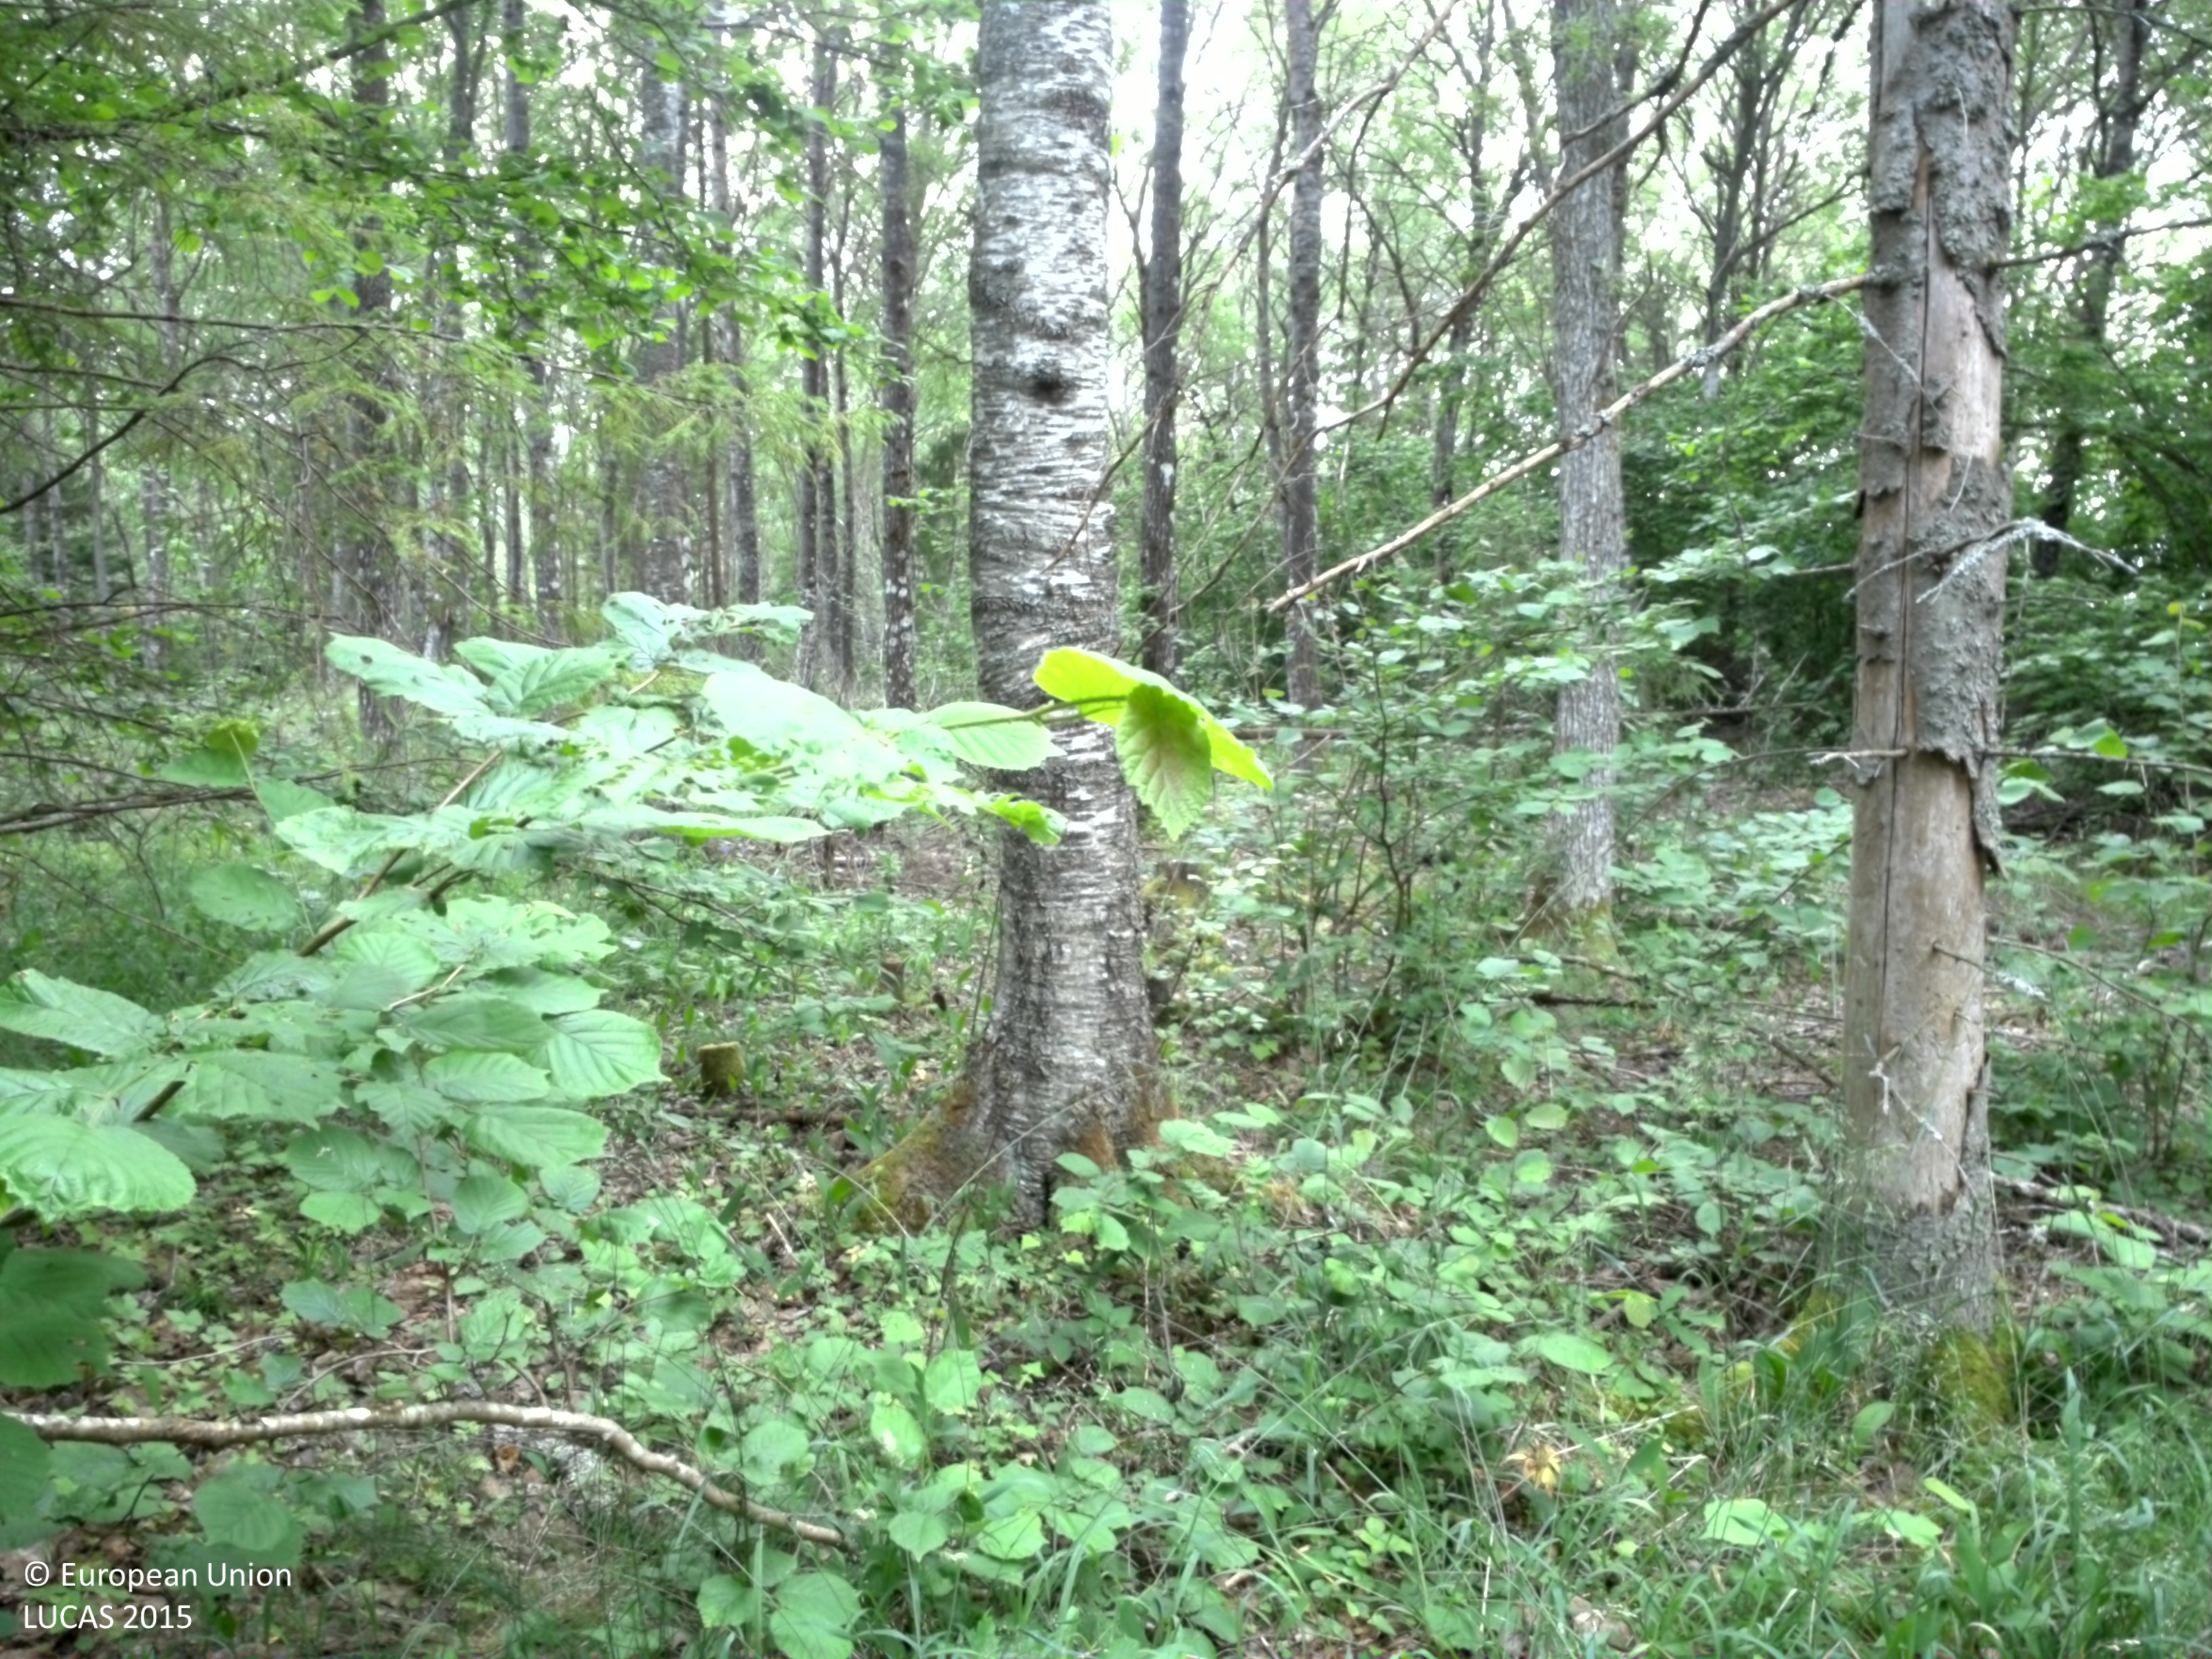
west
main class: Woodland
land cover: Broadleaved woodland
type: hemiboreal forest and nemoral coniferous forest and mixed broadleaved-coniferous forest
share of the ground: > 75 %
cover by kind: broadleaved forest trees 70 %, herbaceous plants 25 %, coniferous forest trees 5 %
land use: Forestry
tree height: > 5 m
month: July
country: SE
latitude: 59.7983
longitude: 17.5329
